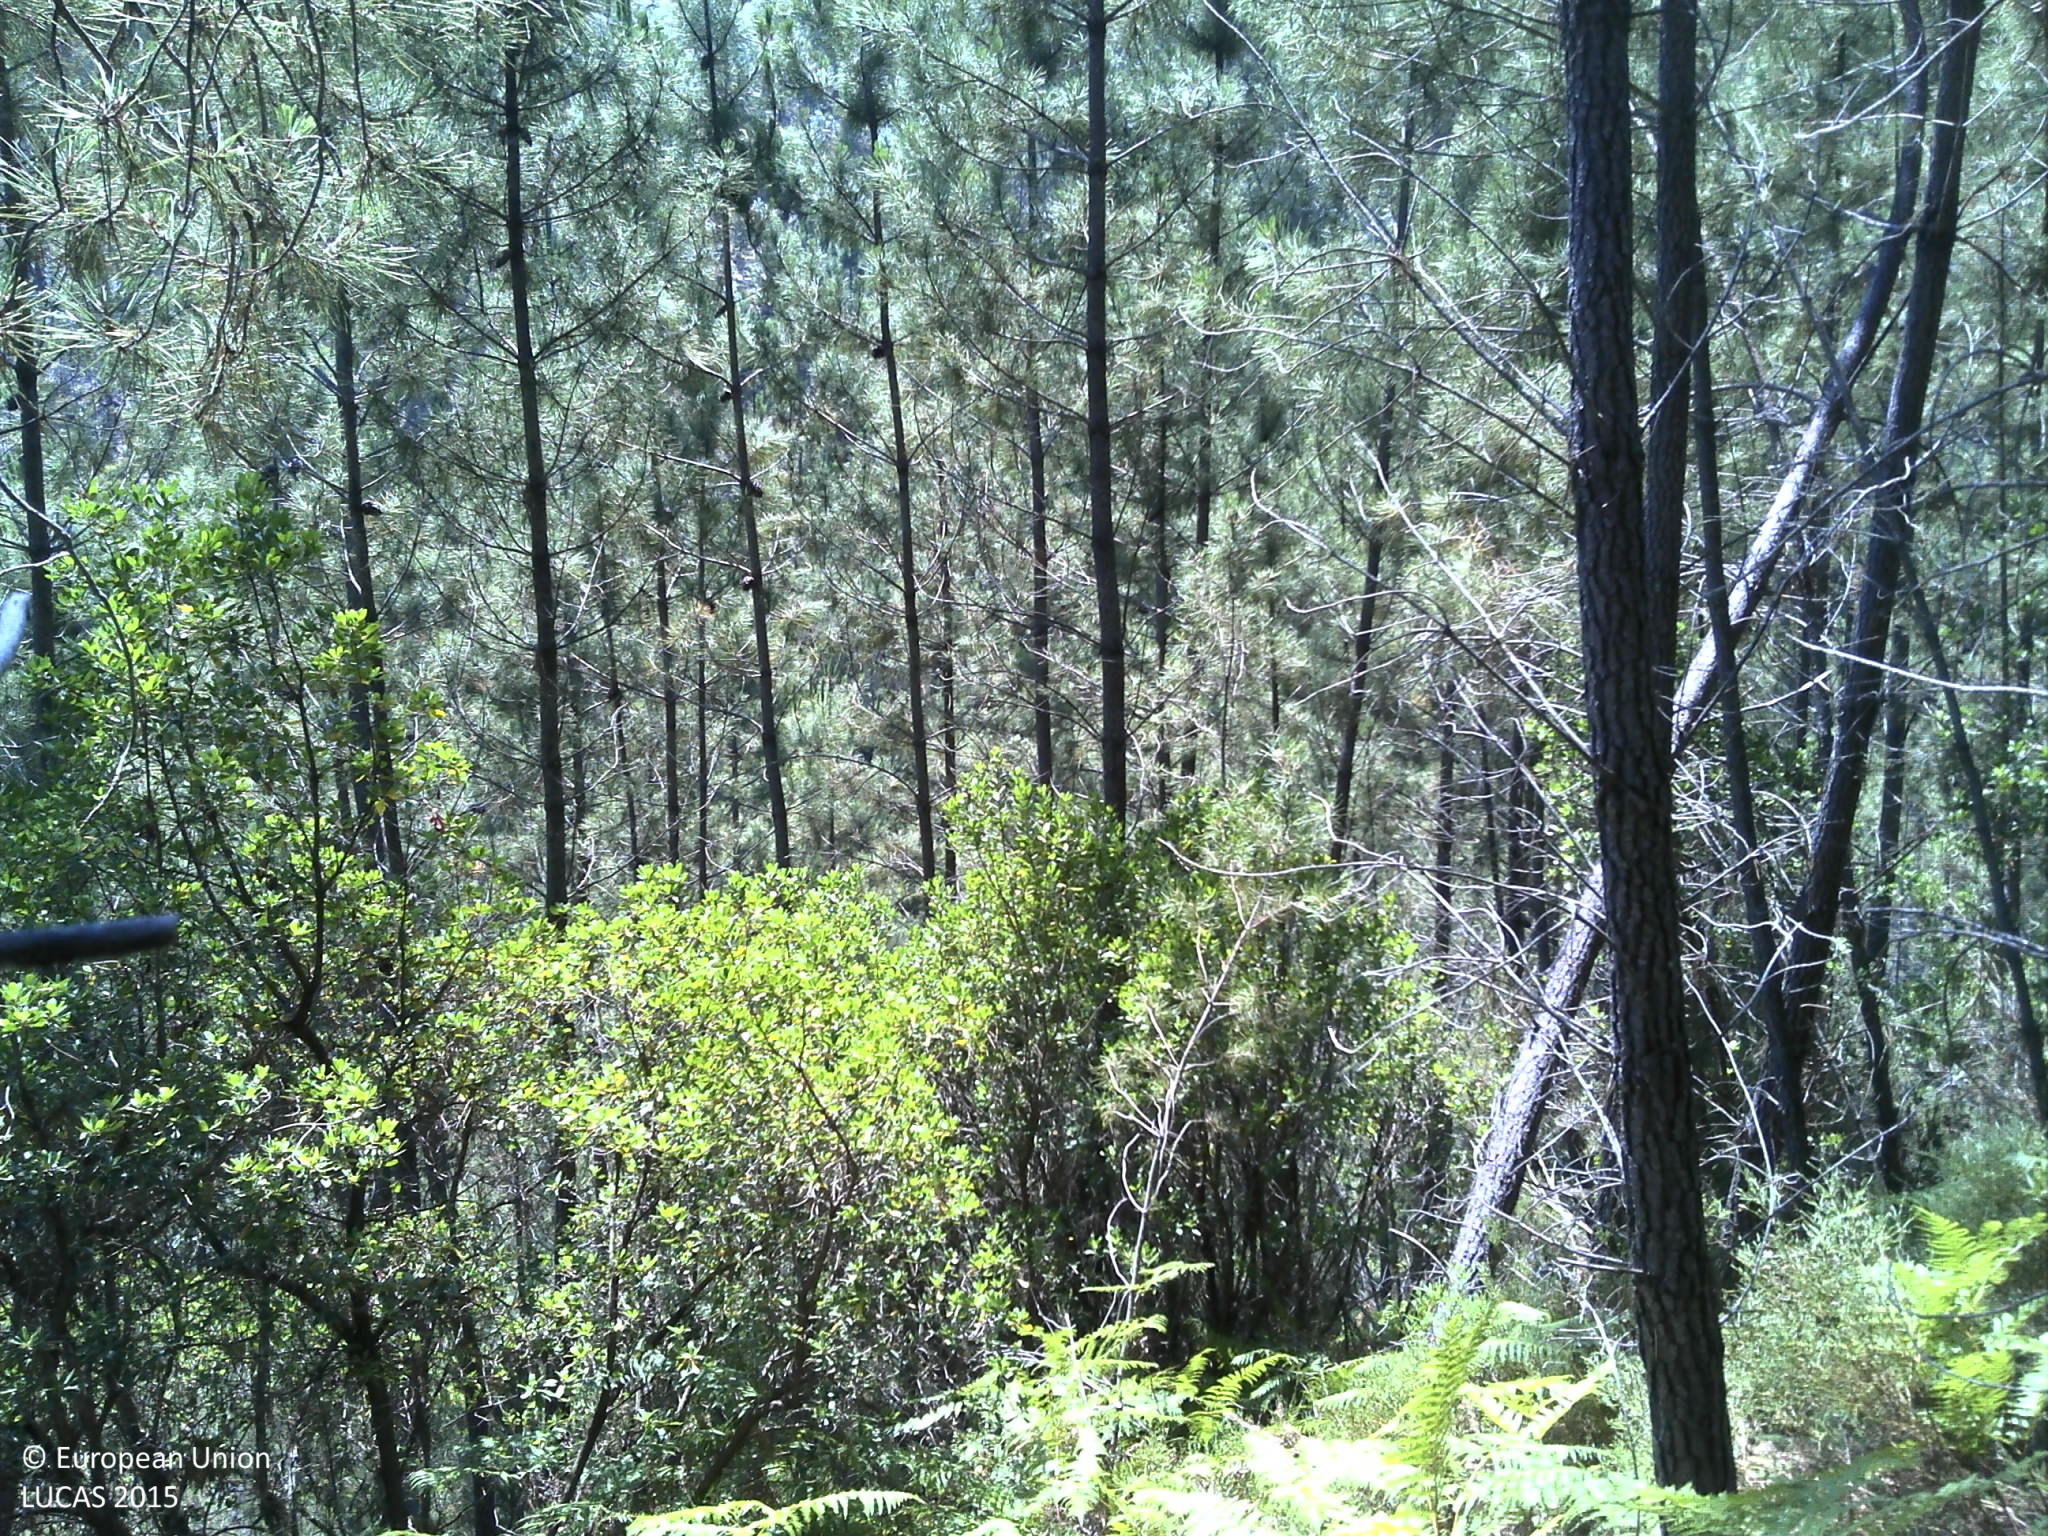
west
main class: Woodland
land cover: Pine dominated coniferous woodland
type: coniferous forest of the mediterranean region
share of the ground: 25 - 50 %
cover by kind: shrubs 50 %, coniferous forest trees 35 %, unconsolidated bare surface 15 %
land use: Forestry
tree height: > 5 m
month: June
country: PT
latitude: 40.0182
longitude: -8.0546
